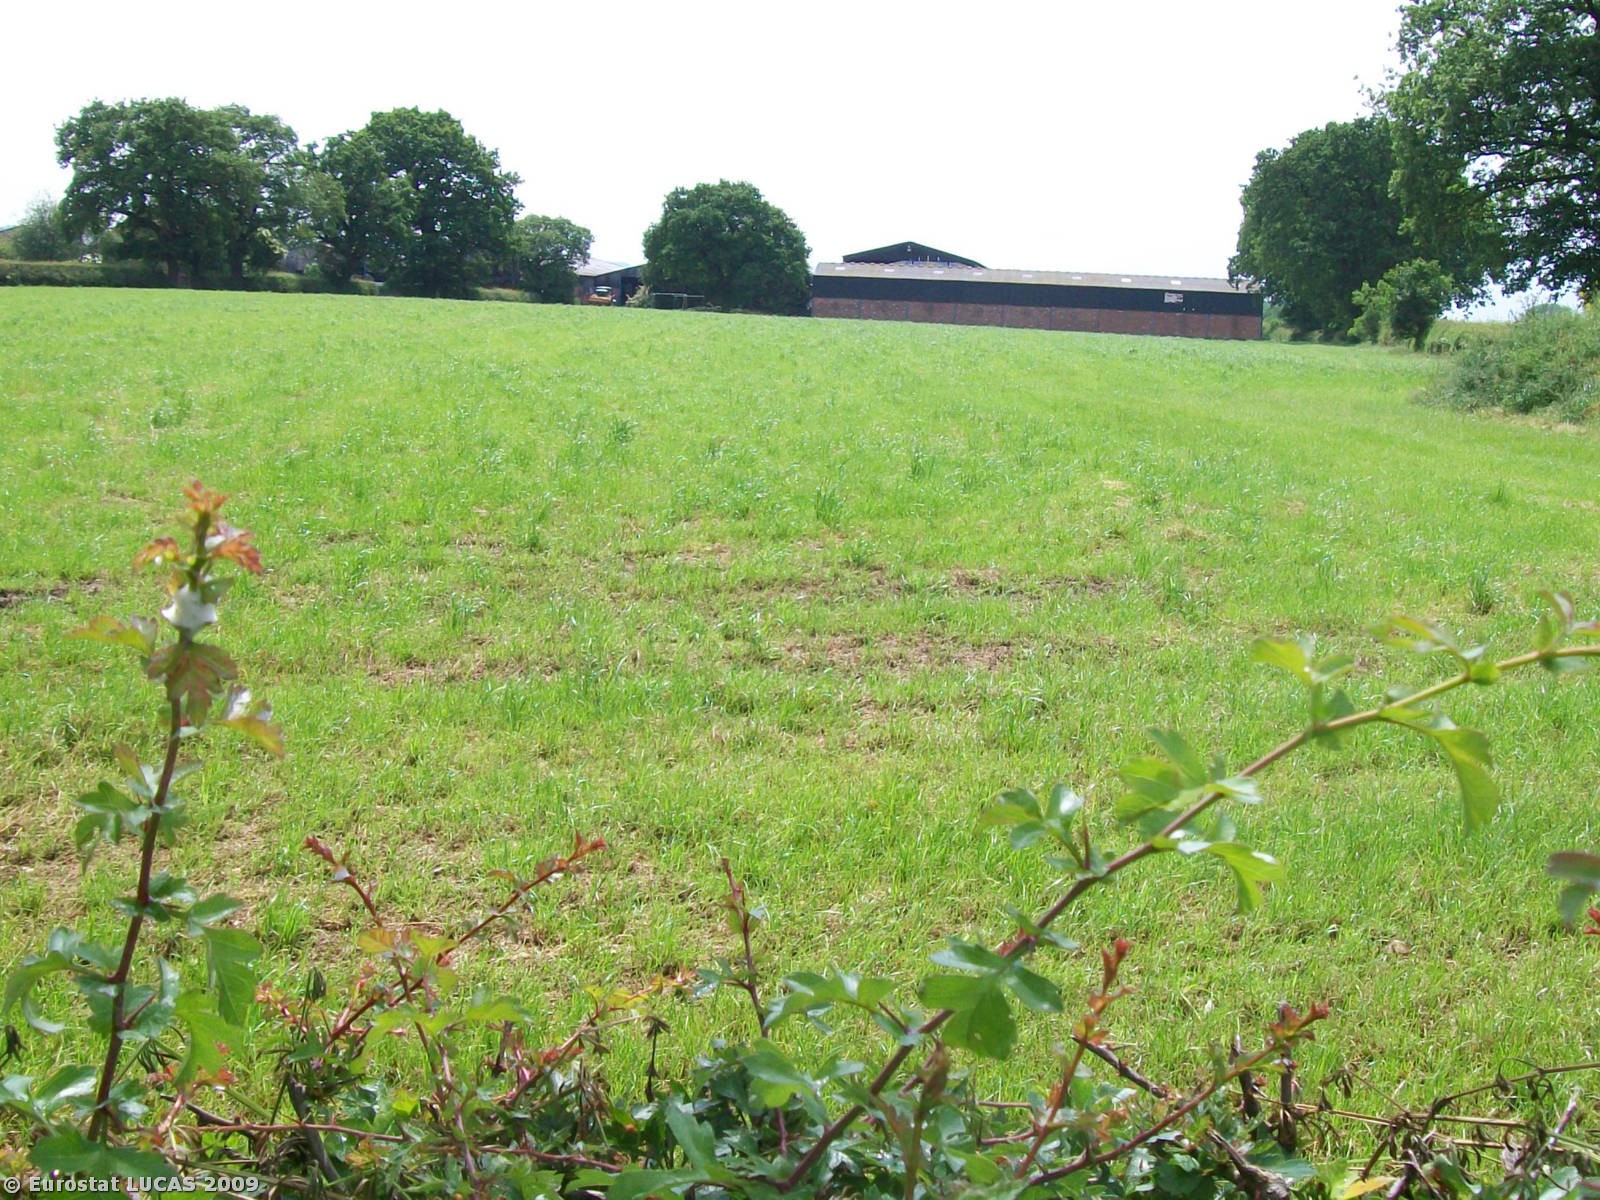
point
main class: Grassland
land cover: Grassland without tree/shrub cover
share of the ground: > 75 %
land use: Agriculture (excluding fallow land and kitchen gardens)
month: June
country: GB
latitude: 53.1659
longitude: -2.7089
